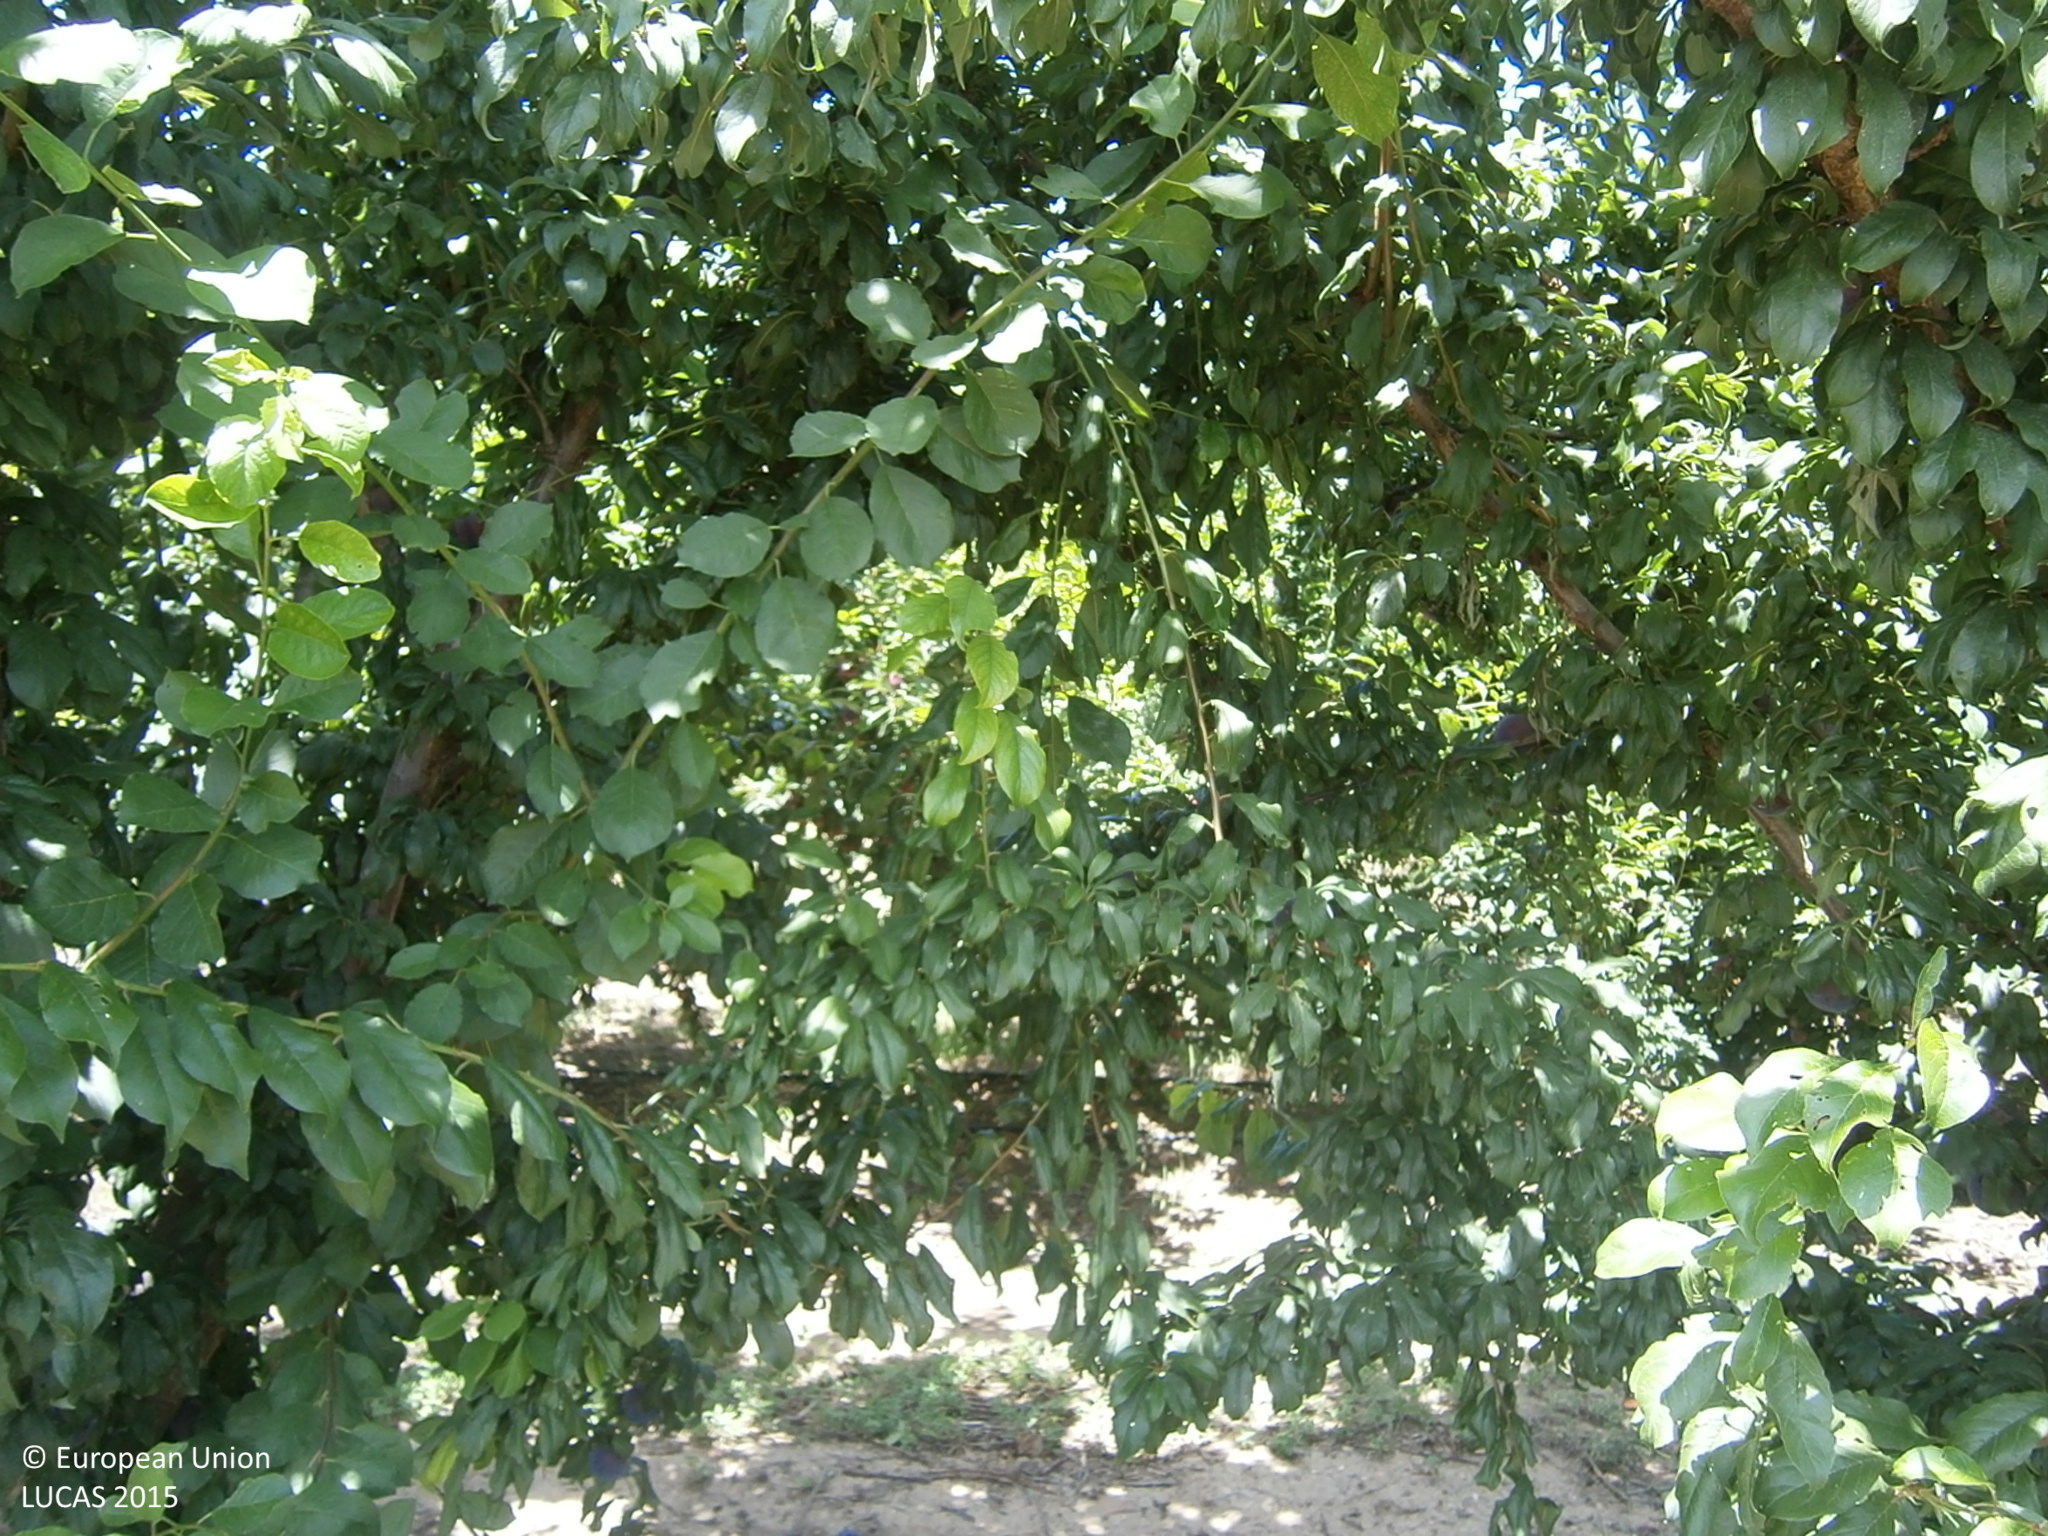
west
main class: Cropland
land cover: Other fruit trees and berries
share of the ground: > 75 %
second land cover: Spontaneously vegetated surfaces
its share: 10 - 25 %
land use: Agriculture (excluding fallow land and kitchen gardens)
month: June
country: ES
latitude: 38.9018
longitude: -6.6800
